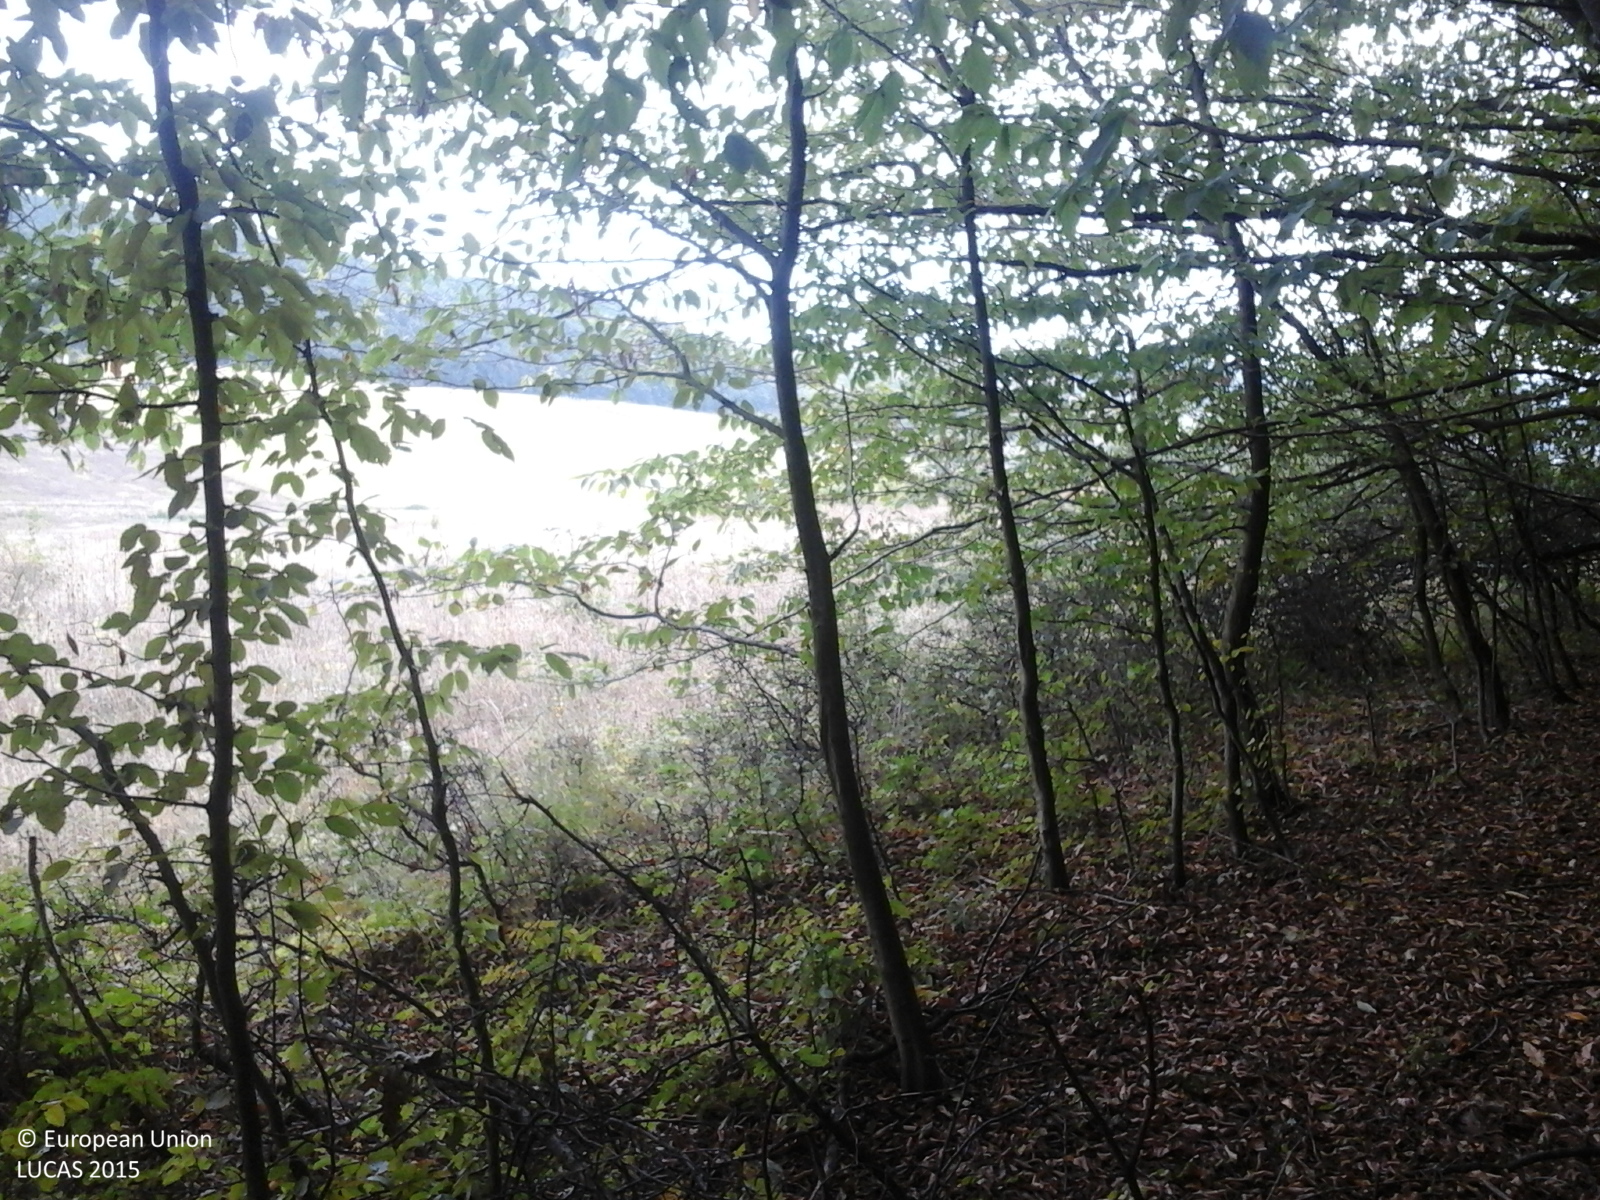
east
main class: Woodland
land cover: Broadleaved woodland
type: acidophilous oak and oak-birch forest
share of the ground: > 75 %
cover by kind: broadleaved forest trees 100 %
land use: Forestry
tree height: > 5 m
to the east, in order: Broadleaved woodland; Grassland without tree/shrub cover; Grassland with sparse tree/shrub cover; Other fruit trees and berries; Grassland with sparse tree/shrub cover; Maize
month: September
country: RO
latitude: 47.2400
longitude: 23.0770
